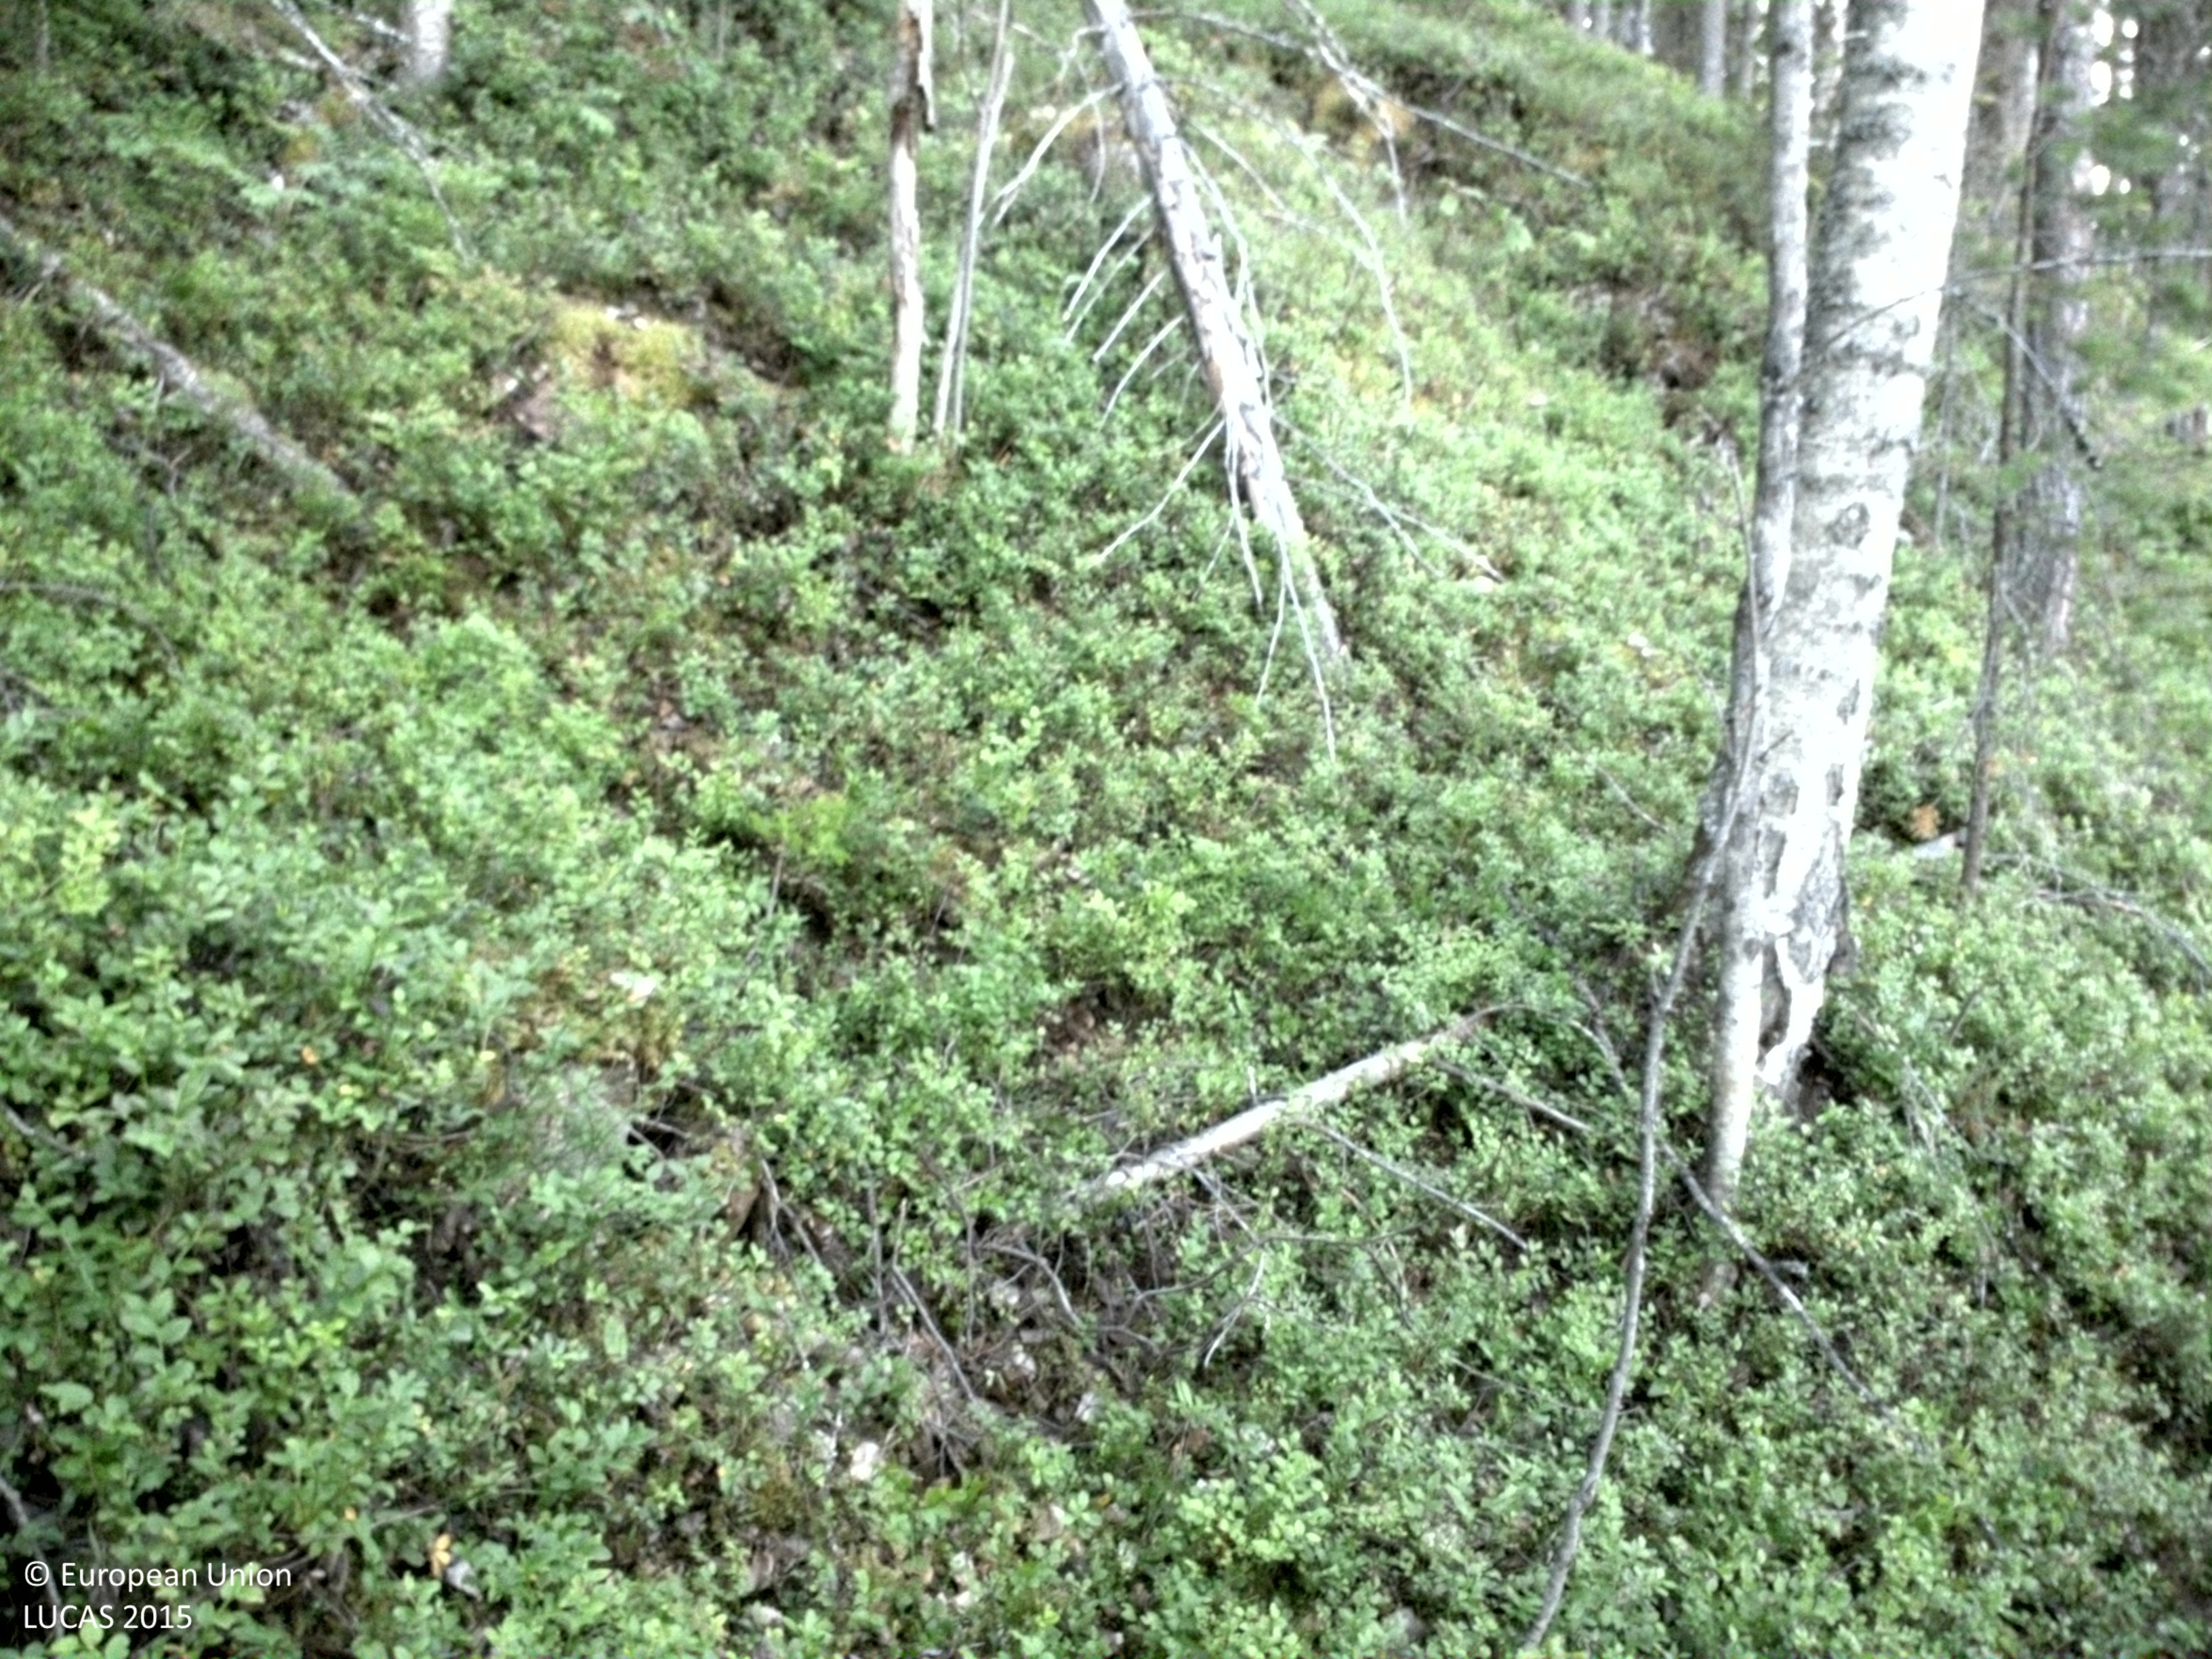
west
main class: Woodland
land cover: Broadleaved woodland
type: hemiboreal forest and nemoral coniferous forest and mixed broadleaved-coniferous forest
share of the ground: 25 - 50 %
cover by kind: shrubs 50 %, broadleaved forest trees 40 %, coniferous forest trees 5 %, consolidated bare surface 5 %
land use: Amenities, museums, leisure
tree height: < 5 m
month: August
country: SE
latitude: 66.3384
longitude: 20.6995
